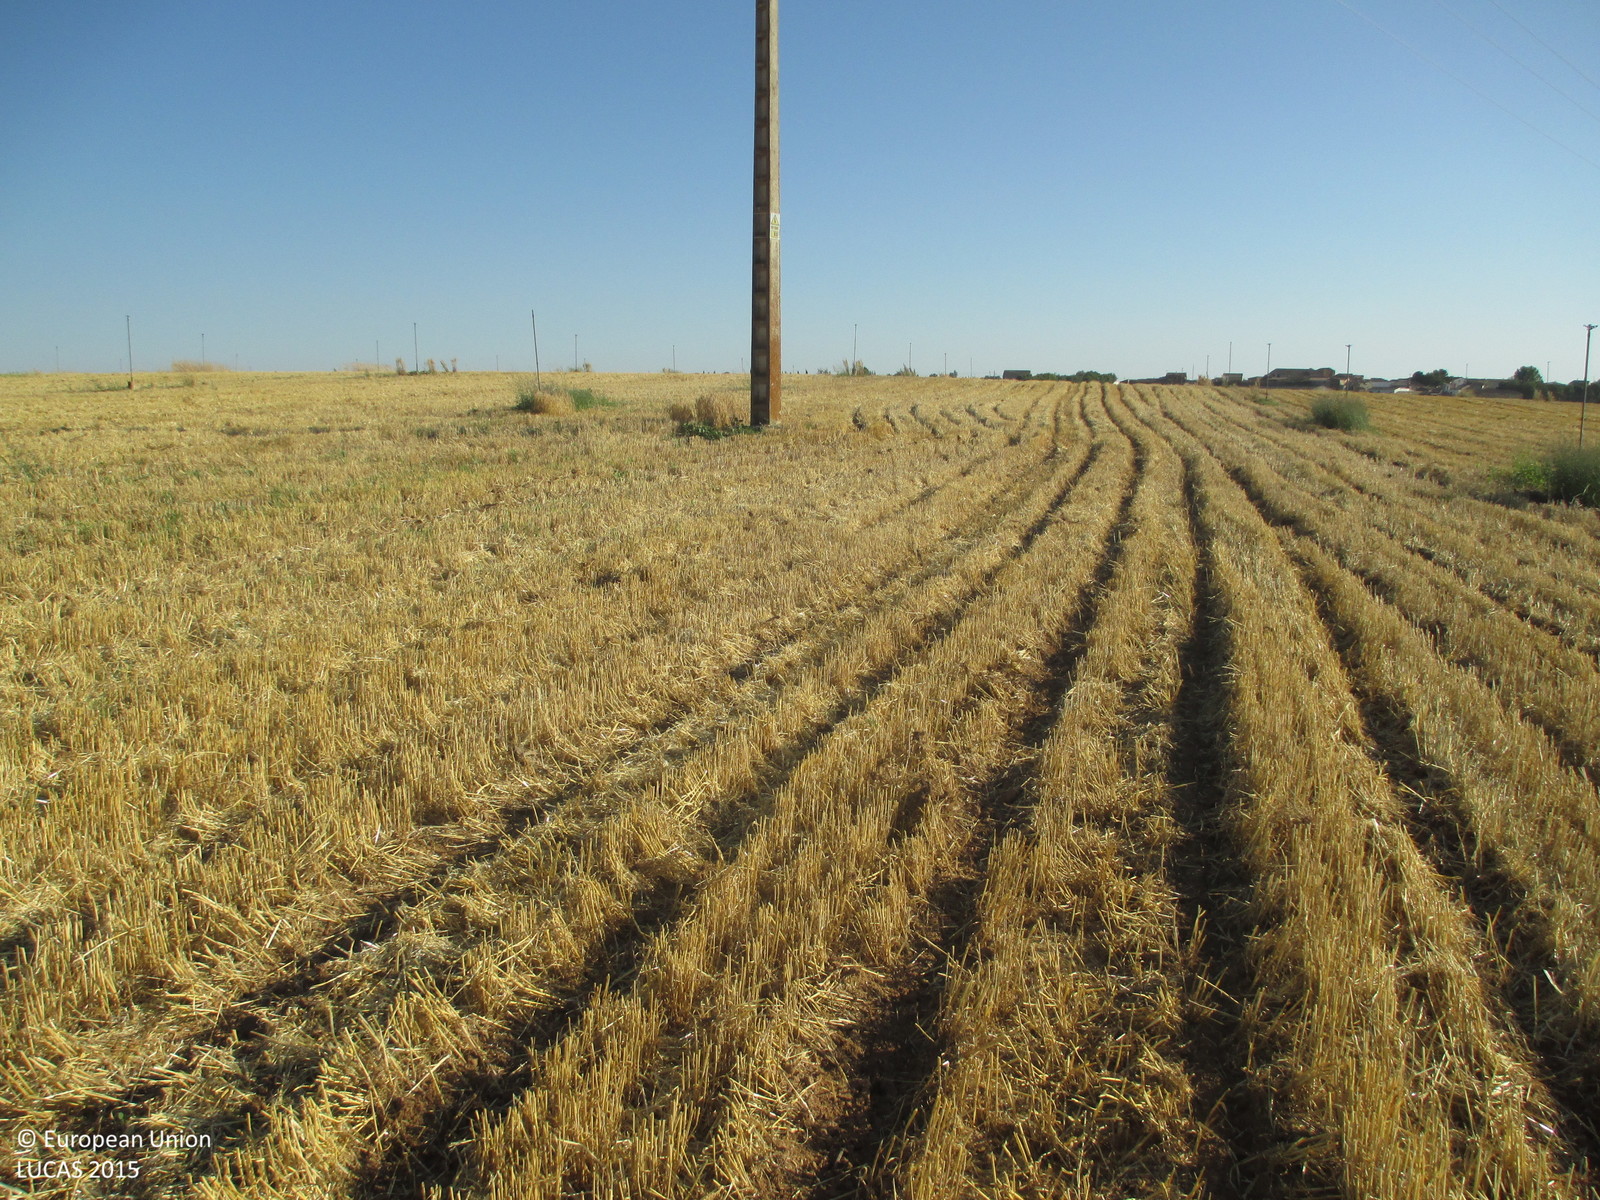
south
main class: Cropland
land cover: Sunflower
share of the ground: < 10 %
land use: Agriculture (excluding fallow land and kitchen gardens)
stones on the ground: < 10 %
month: June
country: ES
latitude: 42.0291
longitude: -0.3725
